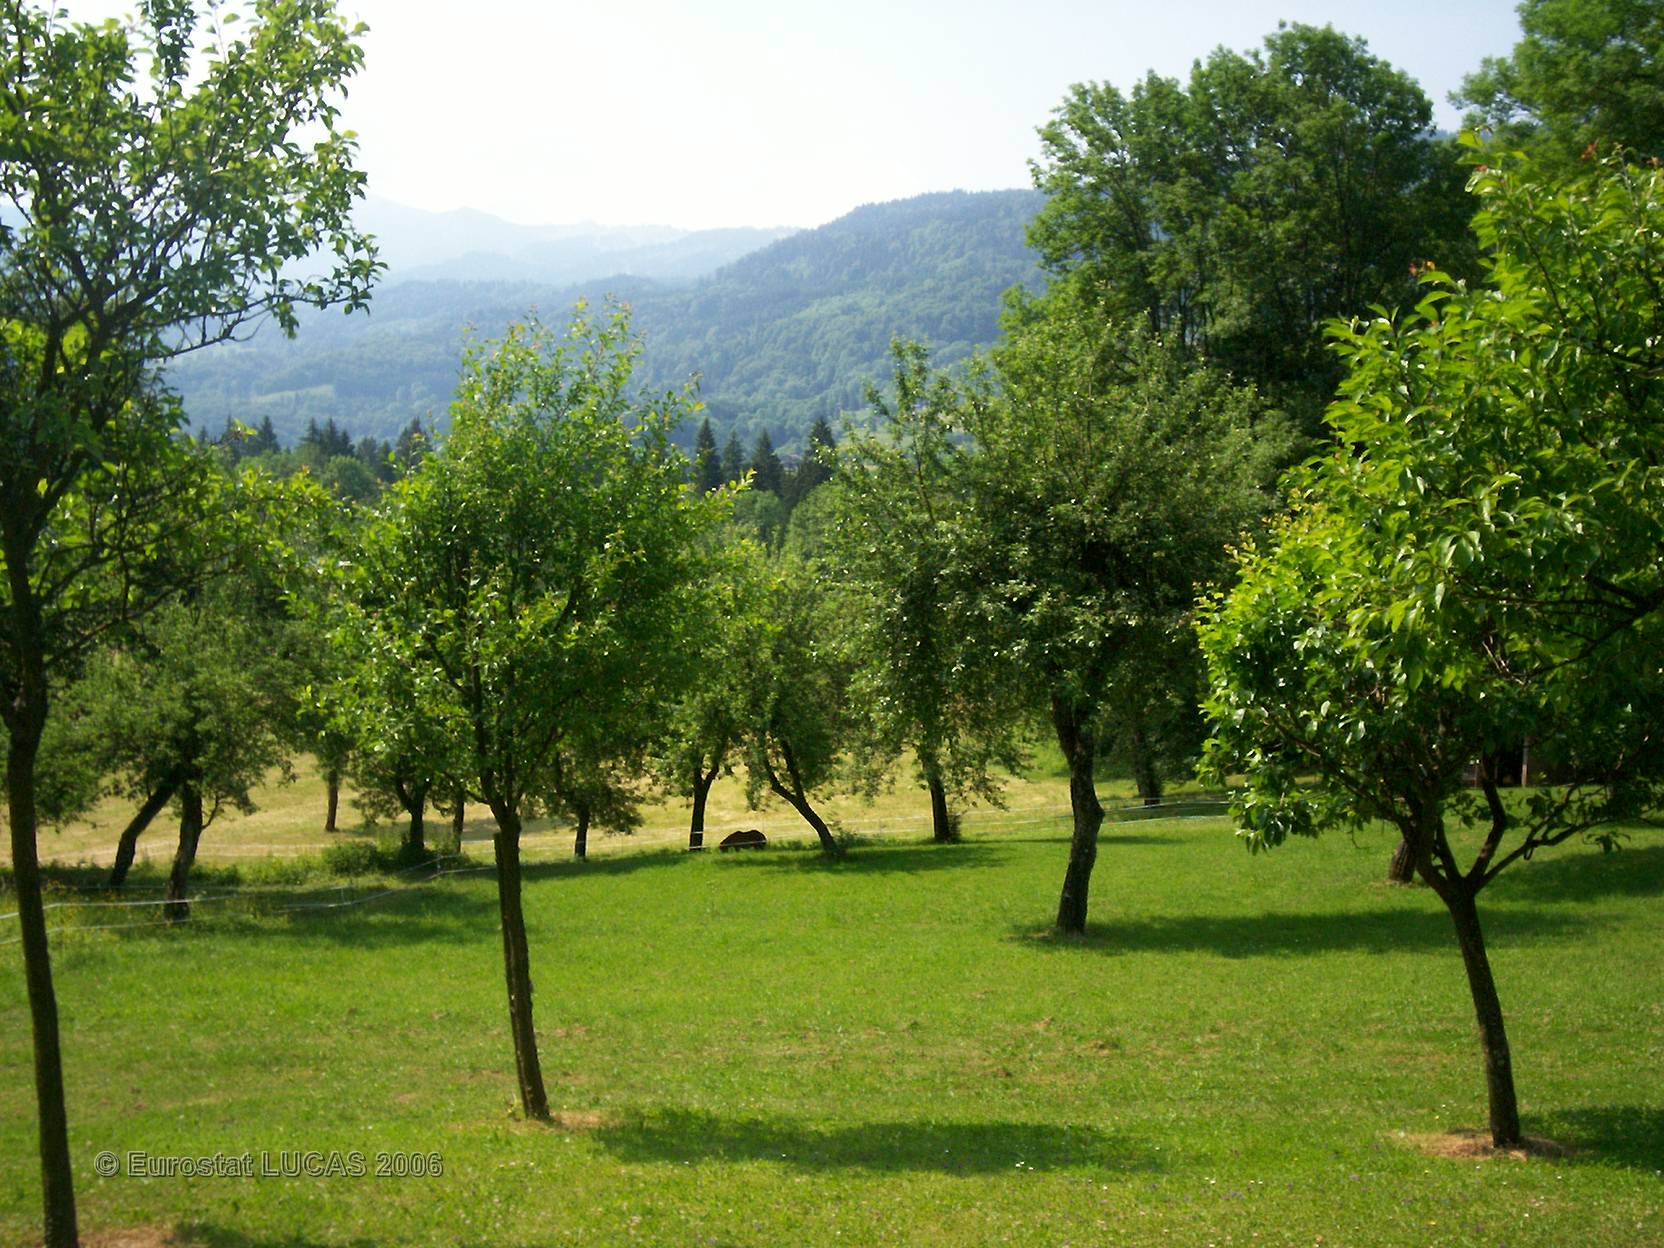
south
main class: Grassland
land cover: Grassland with sparse tree/shrub cover
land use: Agriculture (excluding fallow land and kitchen gardens)
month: June
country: FR
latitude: 46.1006
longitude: 6.6532
